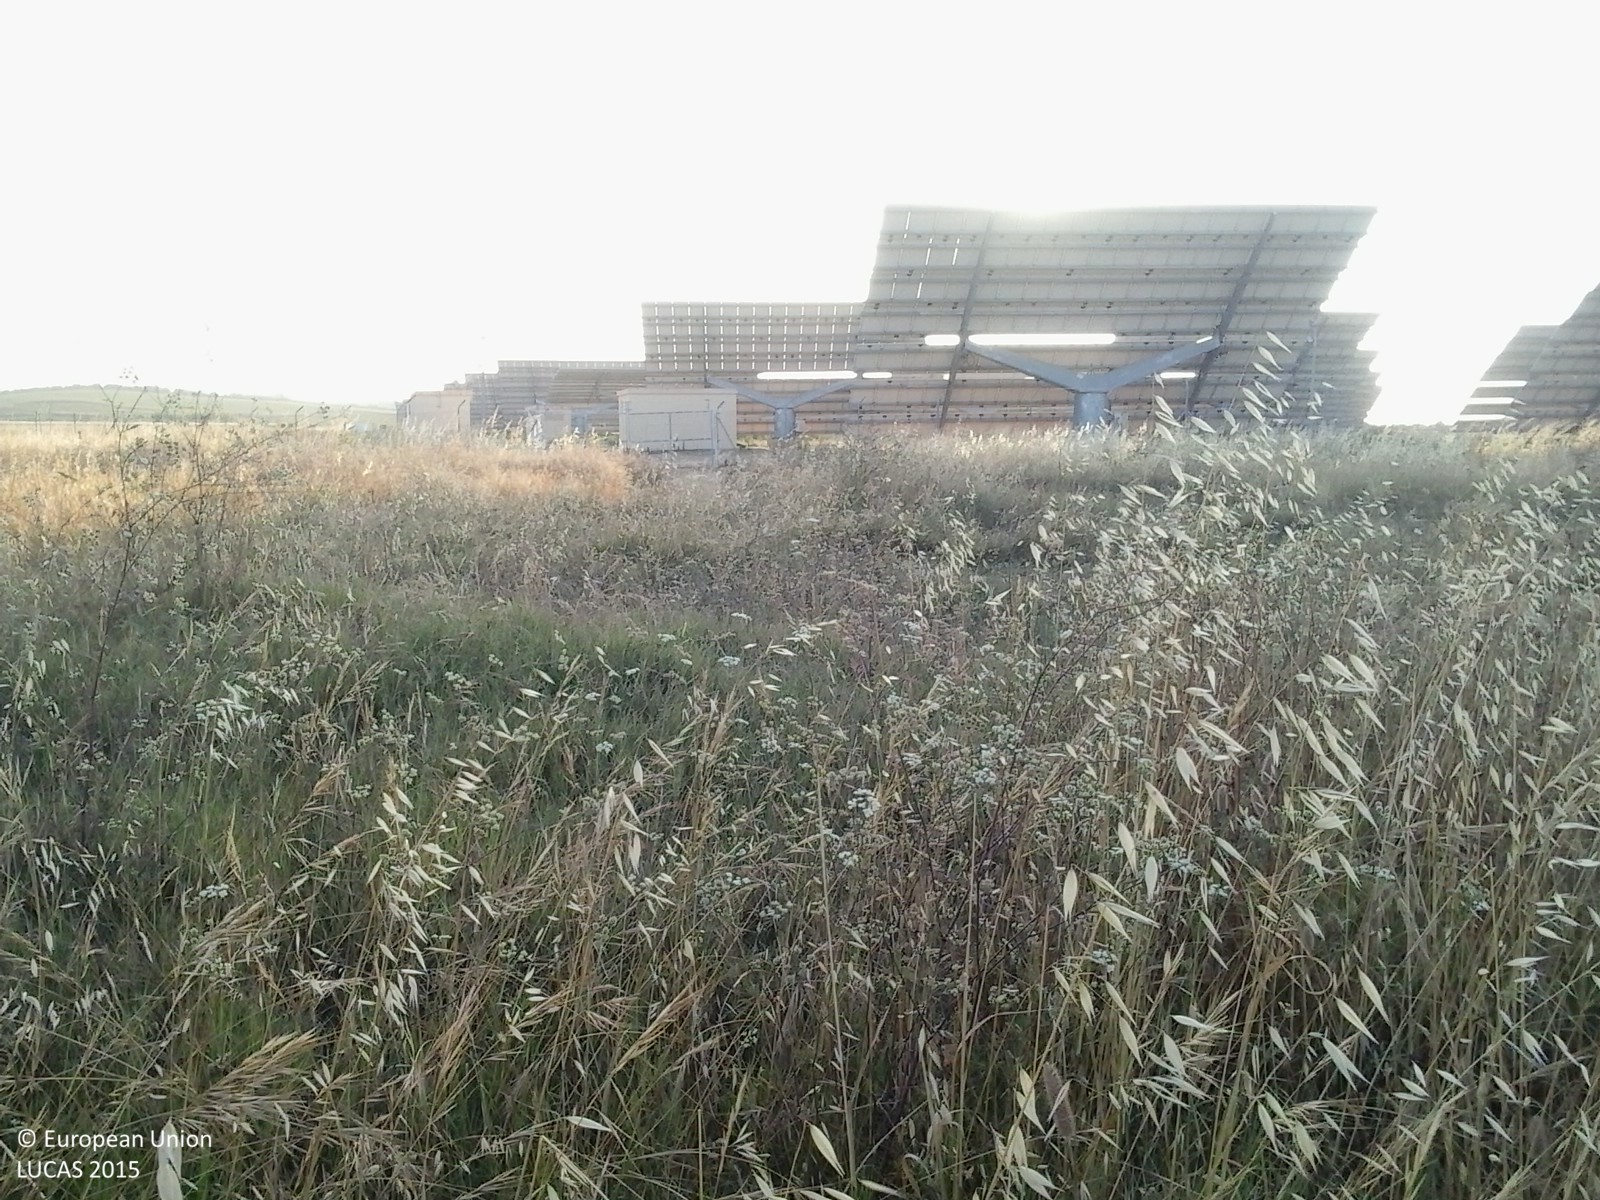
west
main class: Grassland
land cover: Grassland without tree/shrub cover
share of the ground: > 75 %
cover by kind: herbaceous plants 90 %, shrubs 5 %, unconsolidated bare surface 5 %
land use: Abandoned areas
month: June
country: ES
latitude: 37.3981
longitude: -6.4220
